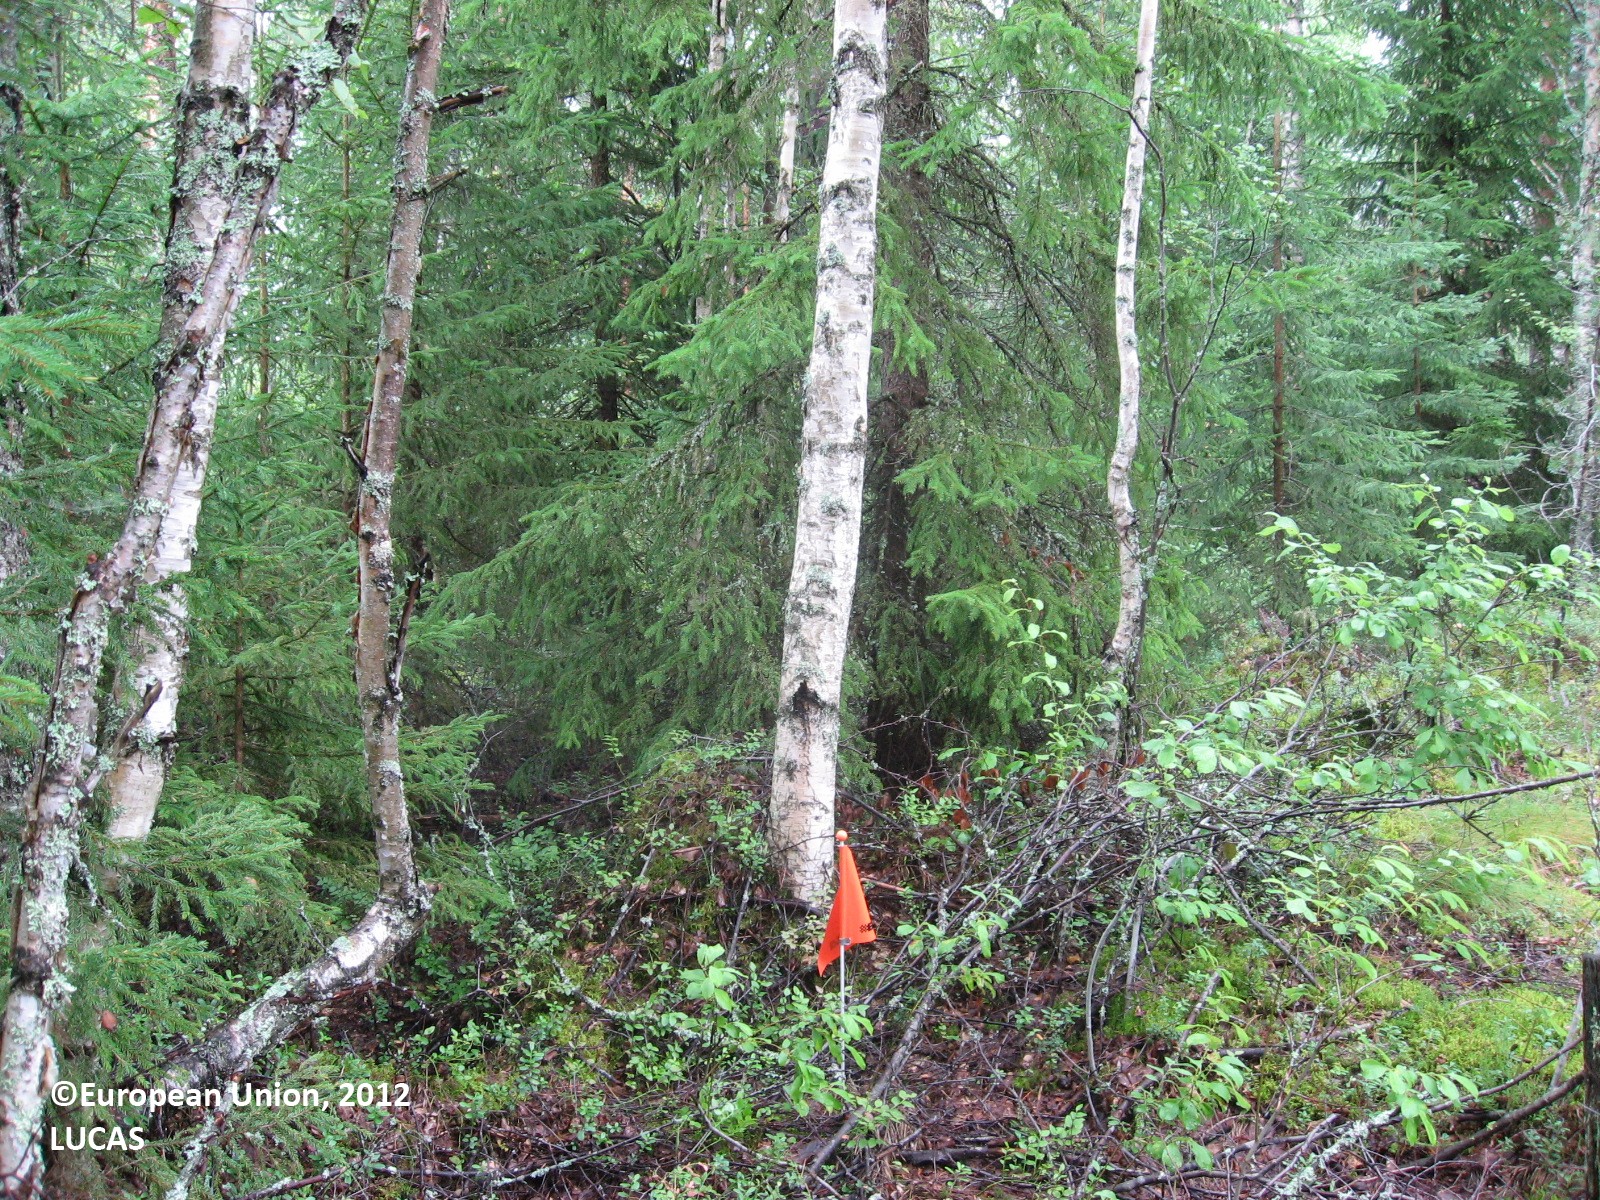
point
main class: Woodland
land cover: Spruce dominated mixed woodland
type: boreal forest
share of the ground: > 75 %
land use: Forestry
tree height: > 5 m
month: August
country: FI
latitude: 61.1080
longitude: 24.7460
